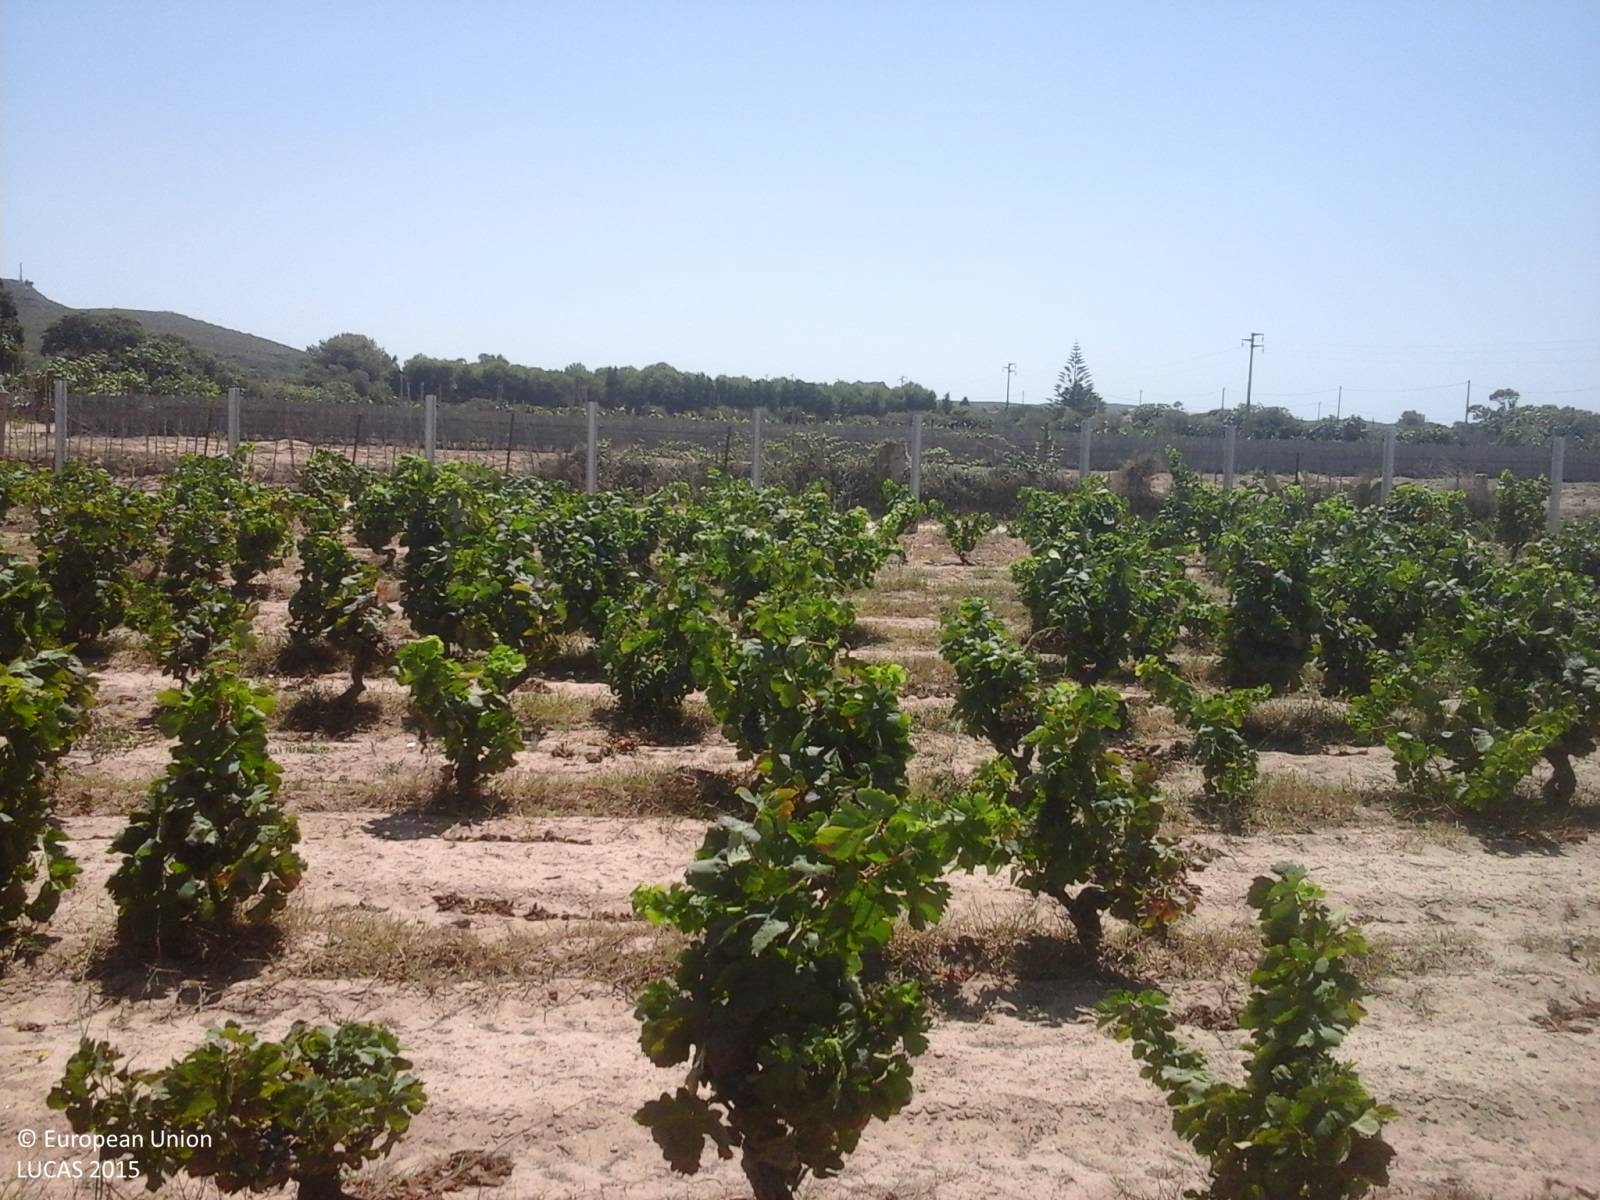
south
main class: Cropland
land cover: Vineyards
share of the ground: 50 - 75 %
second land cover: Other bare soil
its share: > 75 %
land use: Agriculture (excluding fallow land and kitchen gardens)
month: July
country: IT
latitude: 39.0949
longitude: 8.4029
